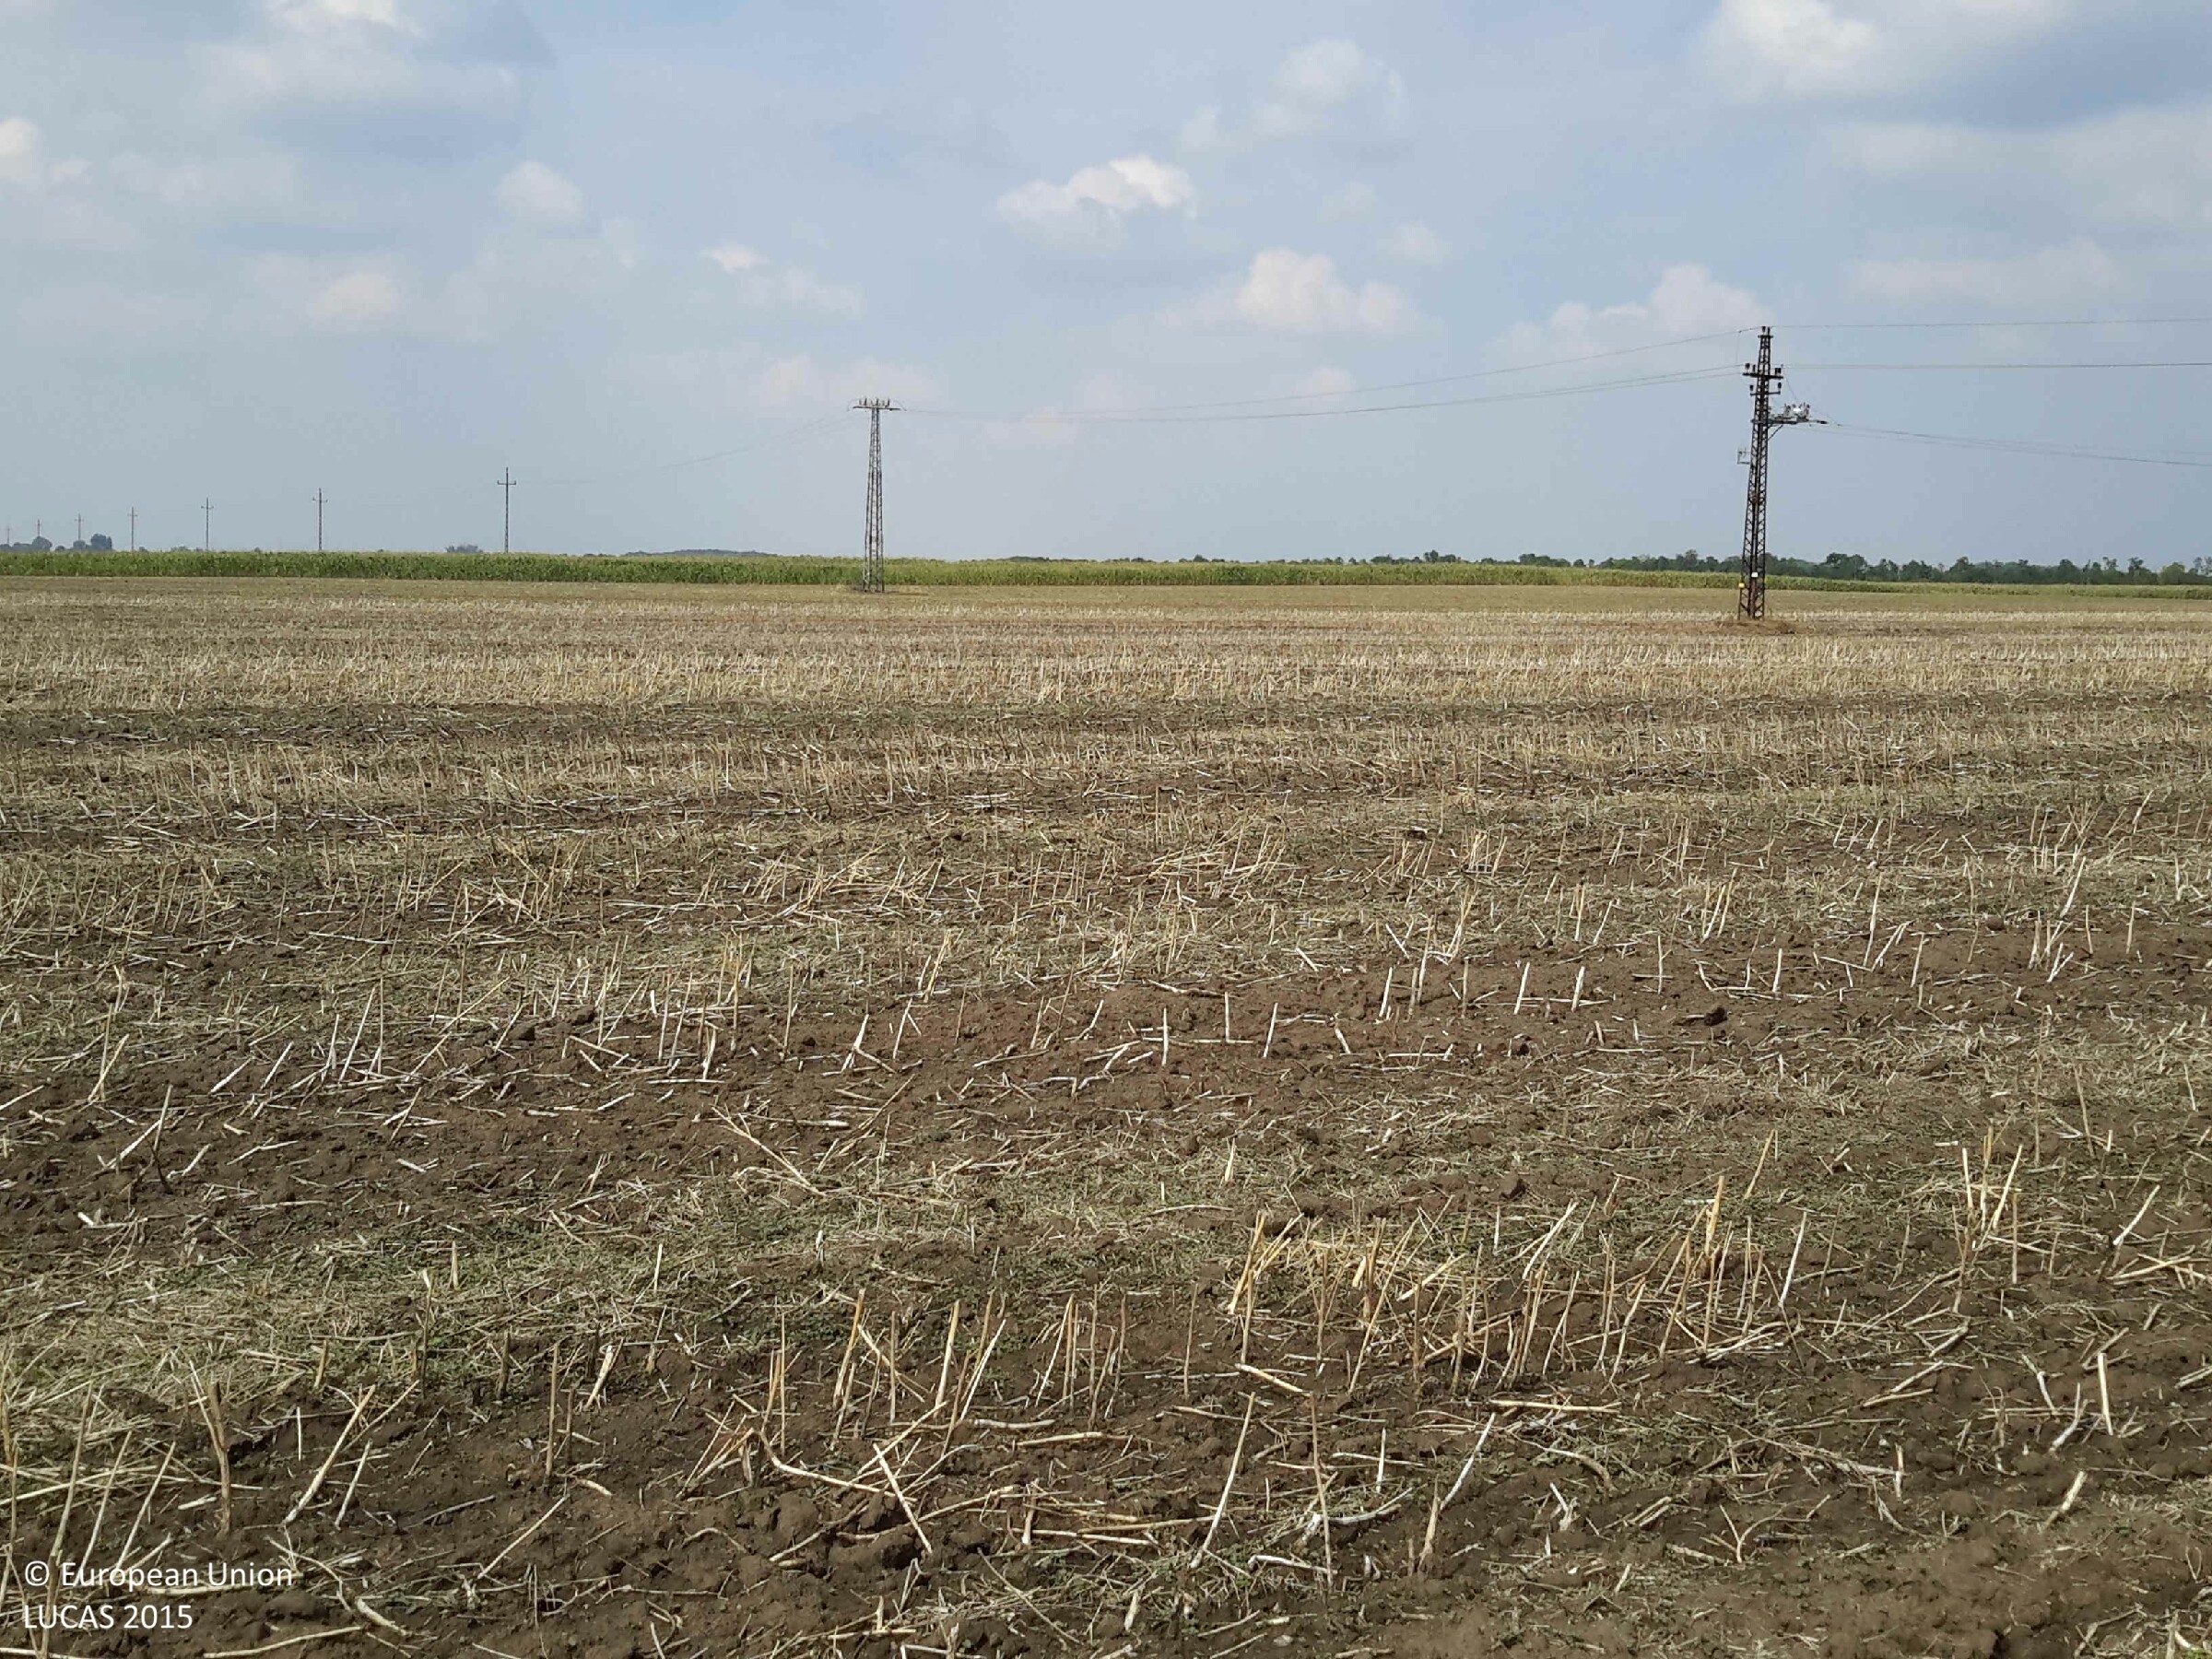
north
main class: Cropland
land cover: Rape and turnip rape
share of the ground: < 10 %
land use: Agriculture (excluding fallow land and kitchen gardens)
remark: Harvested field
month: August
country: HU
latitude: 47.7570
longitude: 17.4122
